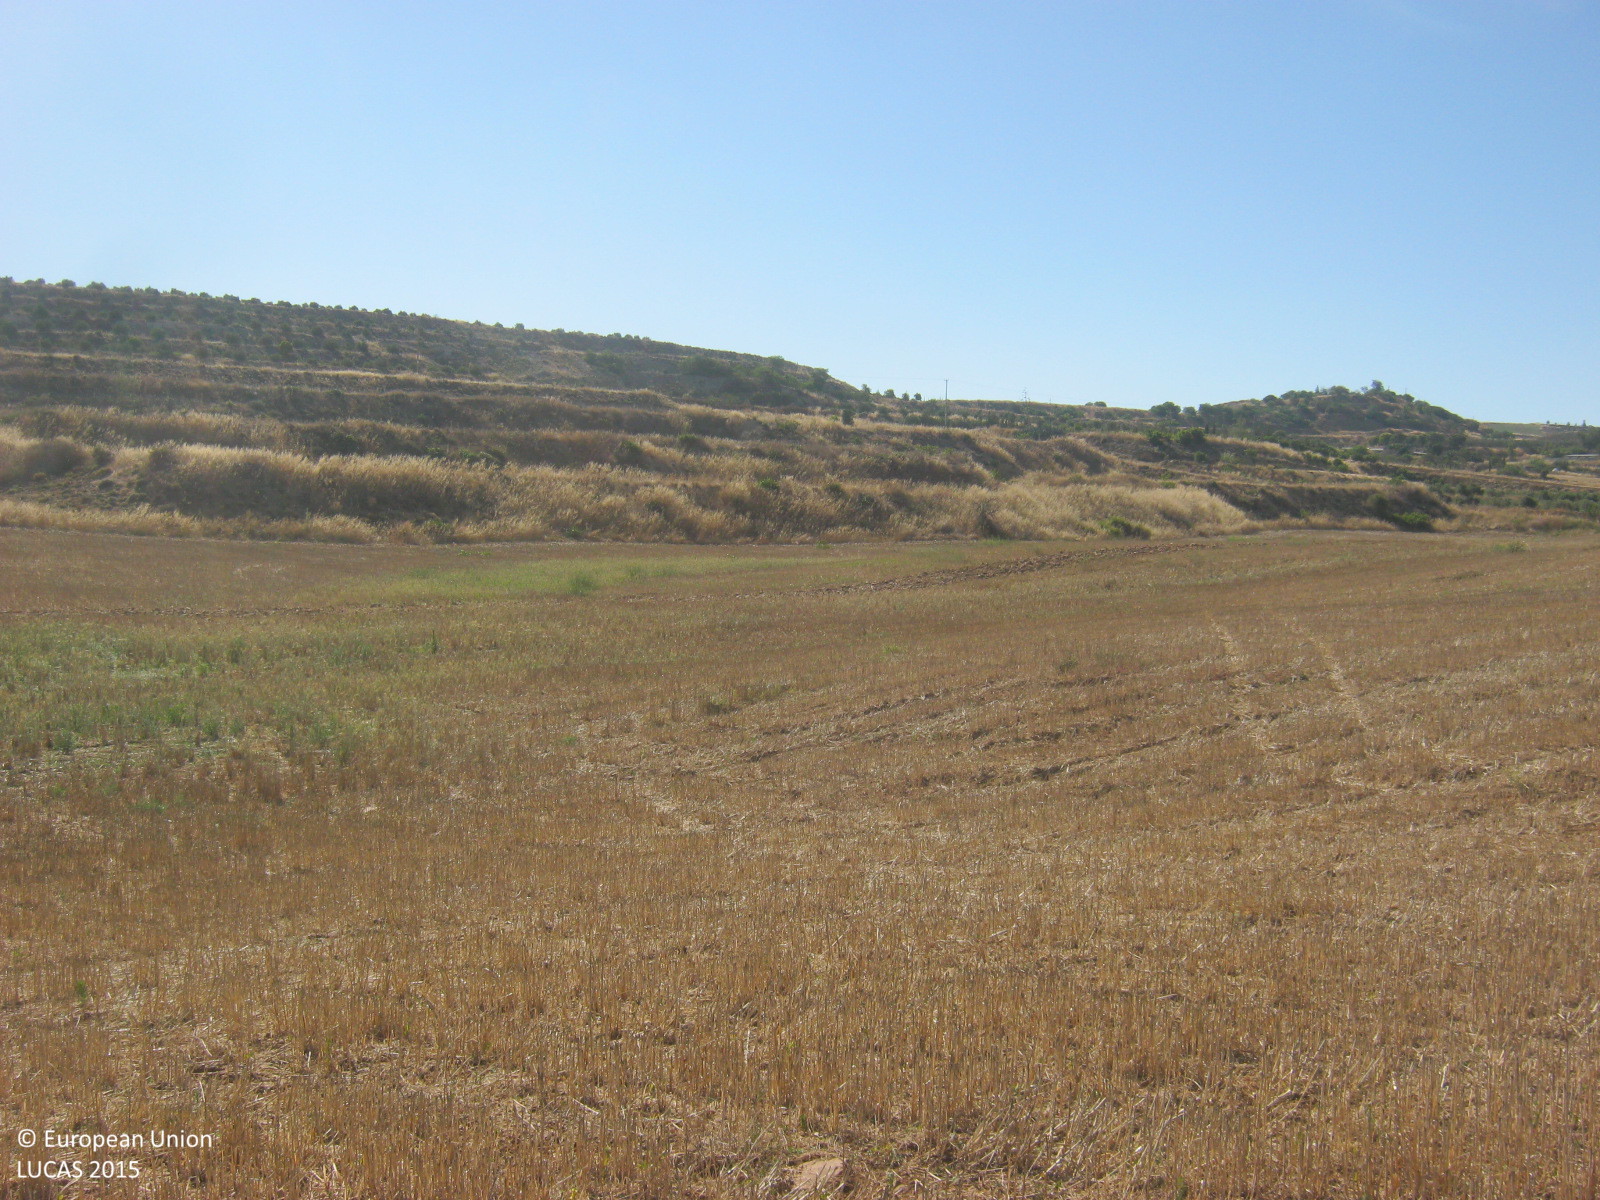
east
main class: Cropland
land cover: Barley
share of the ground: < 10 %
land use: Agriculture (excluding fallow land and kitchen gardens)
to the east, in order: Barley; Shrubland without tree cover; Tracks; Shrubland without tree cover; Grassland without tree/shrub cover; Shrubland without tree cover
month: June
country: CY
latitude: 35.0844
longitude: 33.1839
